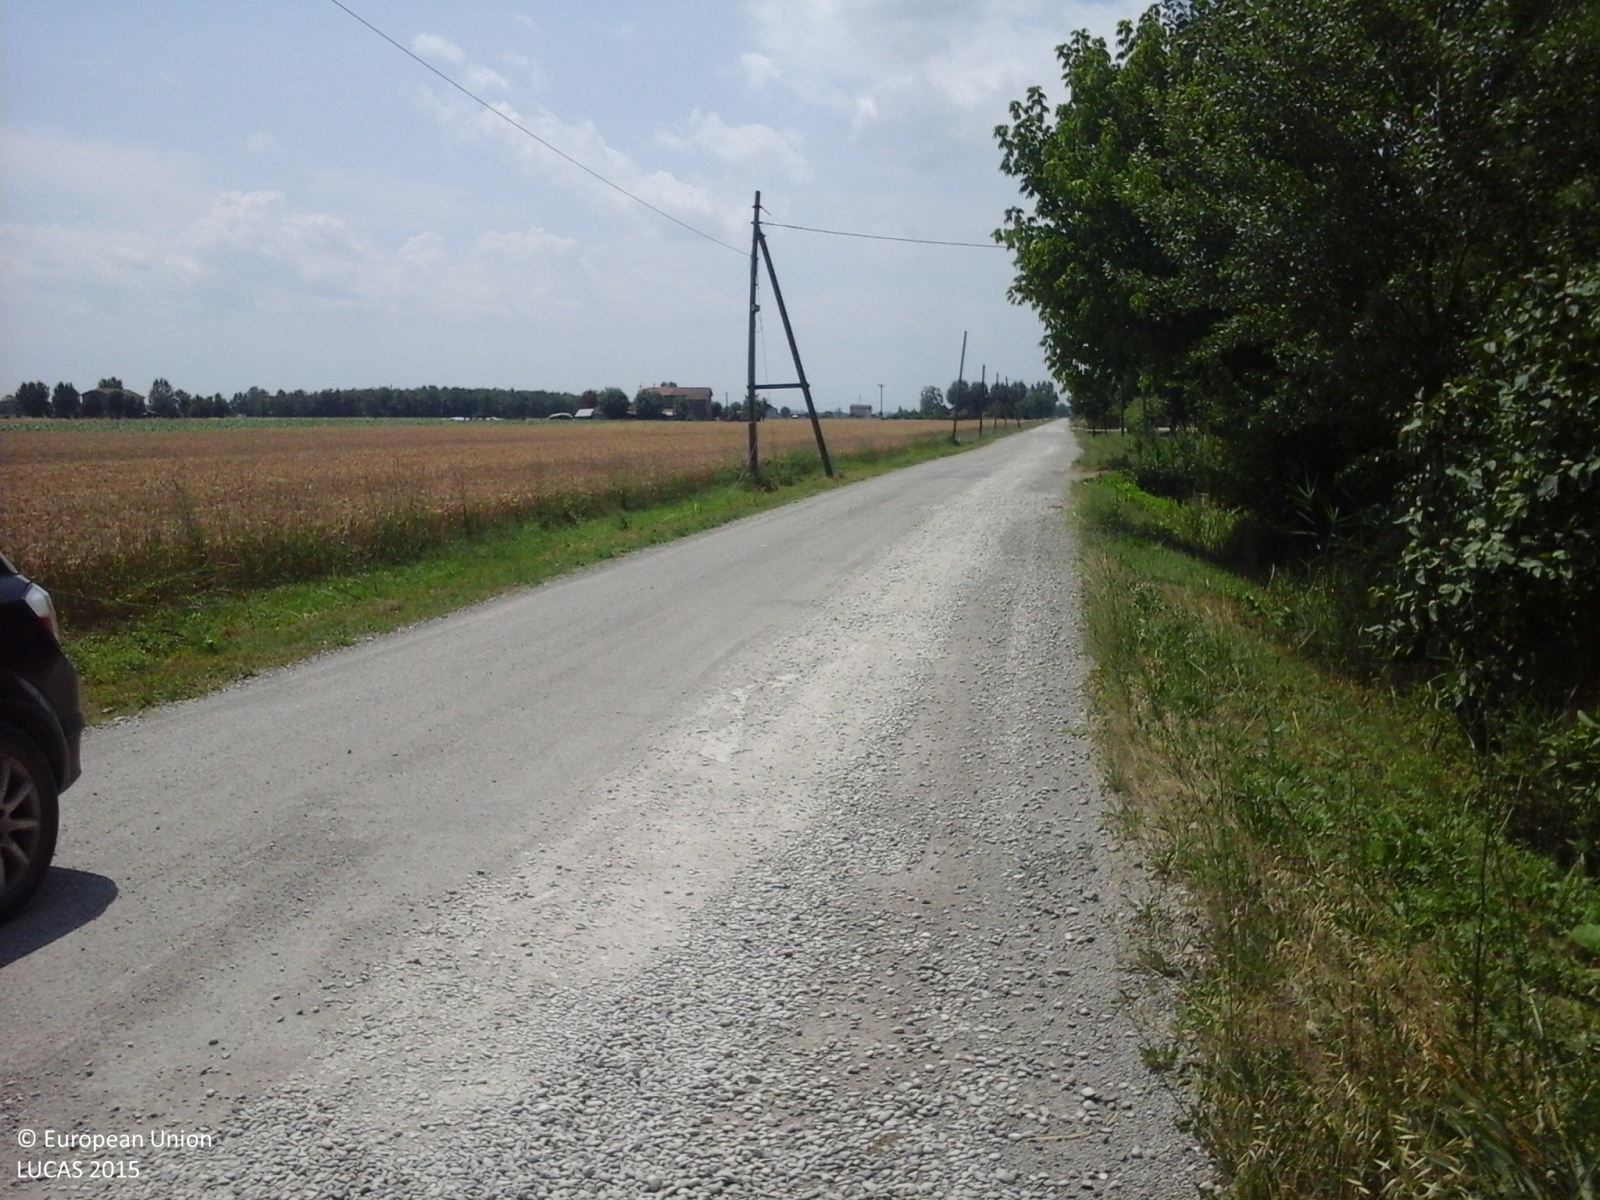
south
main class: Woodland
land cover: Broadleaved woodland
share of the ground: > 75 %
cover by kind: broadleaved forest trees 100 %
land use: Residential
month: June
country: IT
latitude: 44.8137
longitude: 11.0979
